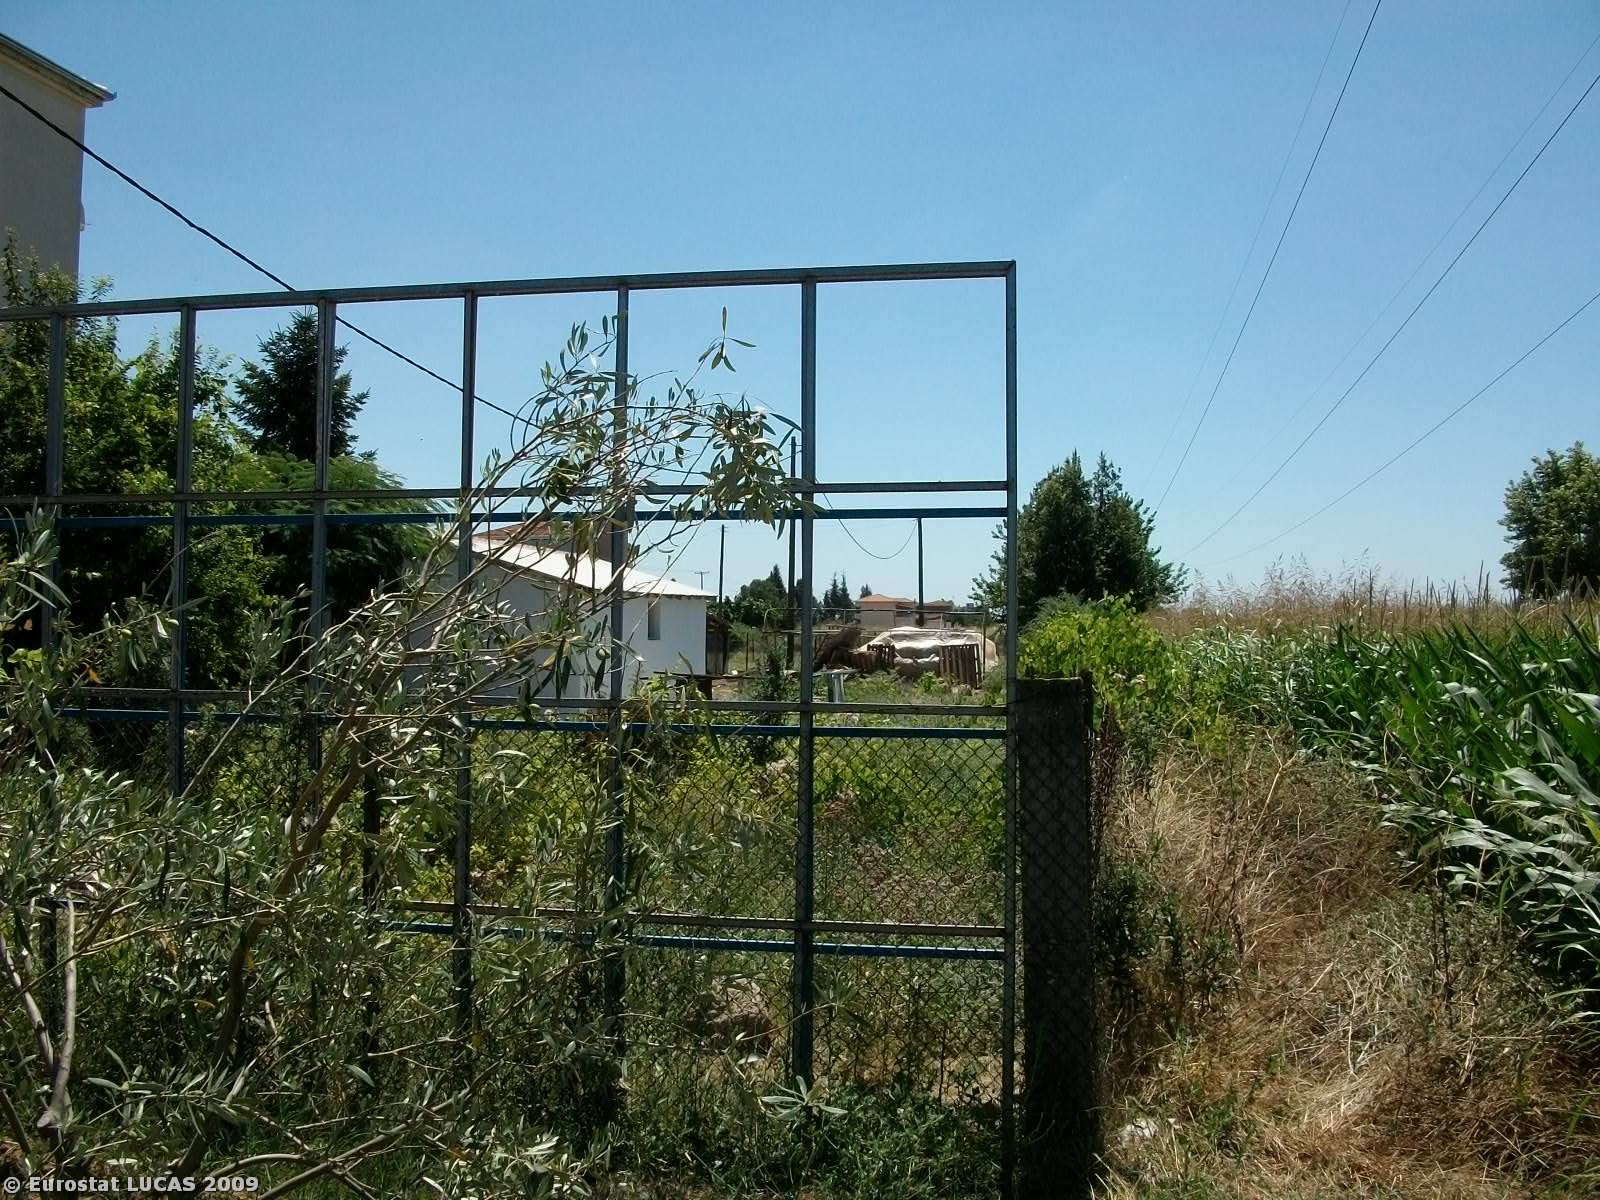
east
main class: Cropland
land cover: Maize
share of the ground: > 75 %
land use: Agriculture (excluding fallow land and kitchen gardens)
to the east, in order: Maize; Fences; Grassland without tree/shrub cover; Electric lines; Grassland without tree/shrub cover; Fences; Grassland without tree/shrub cover; Abandoned hedges; Electric lines; Paved roads, cycling and walking lanes; Shrubland with sparse tree cover; Paved roads, cycling and walking lanes; Durum wheat
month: July
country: GR
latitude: 39.6385
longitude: 21.6941
